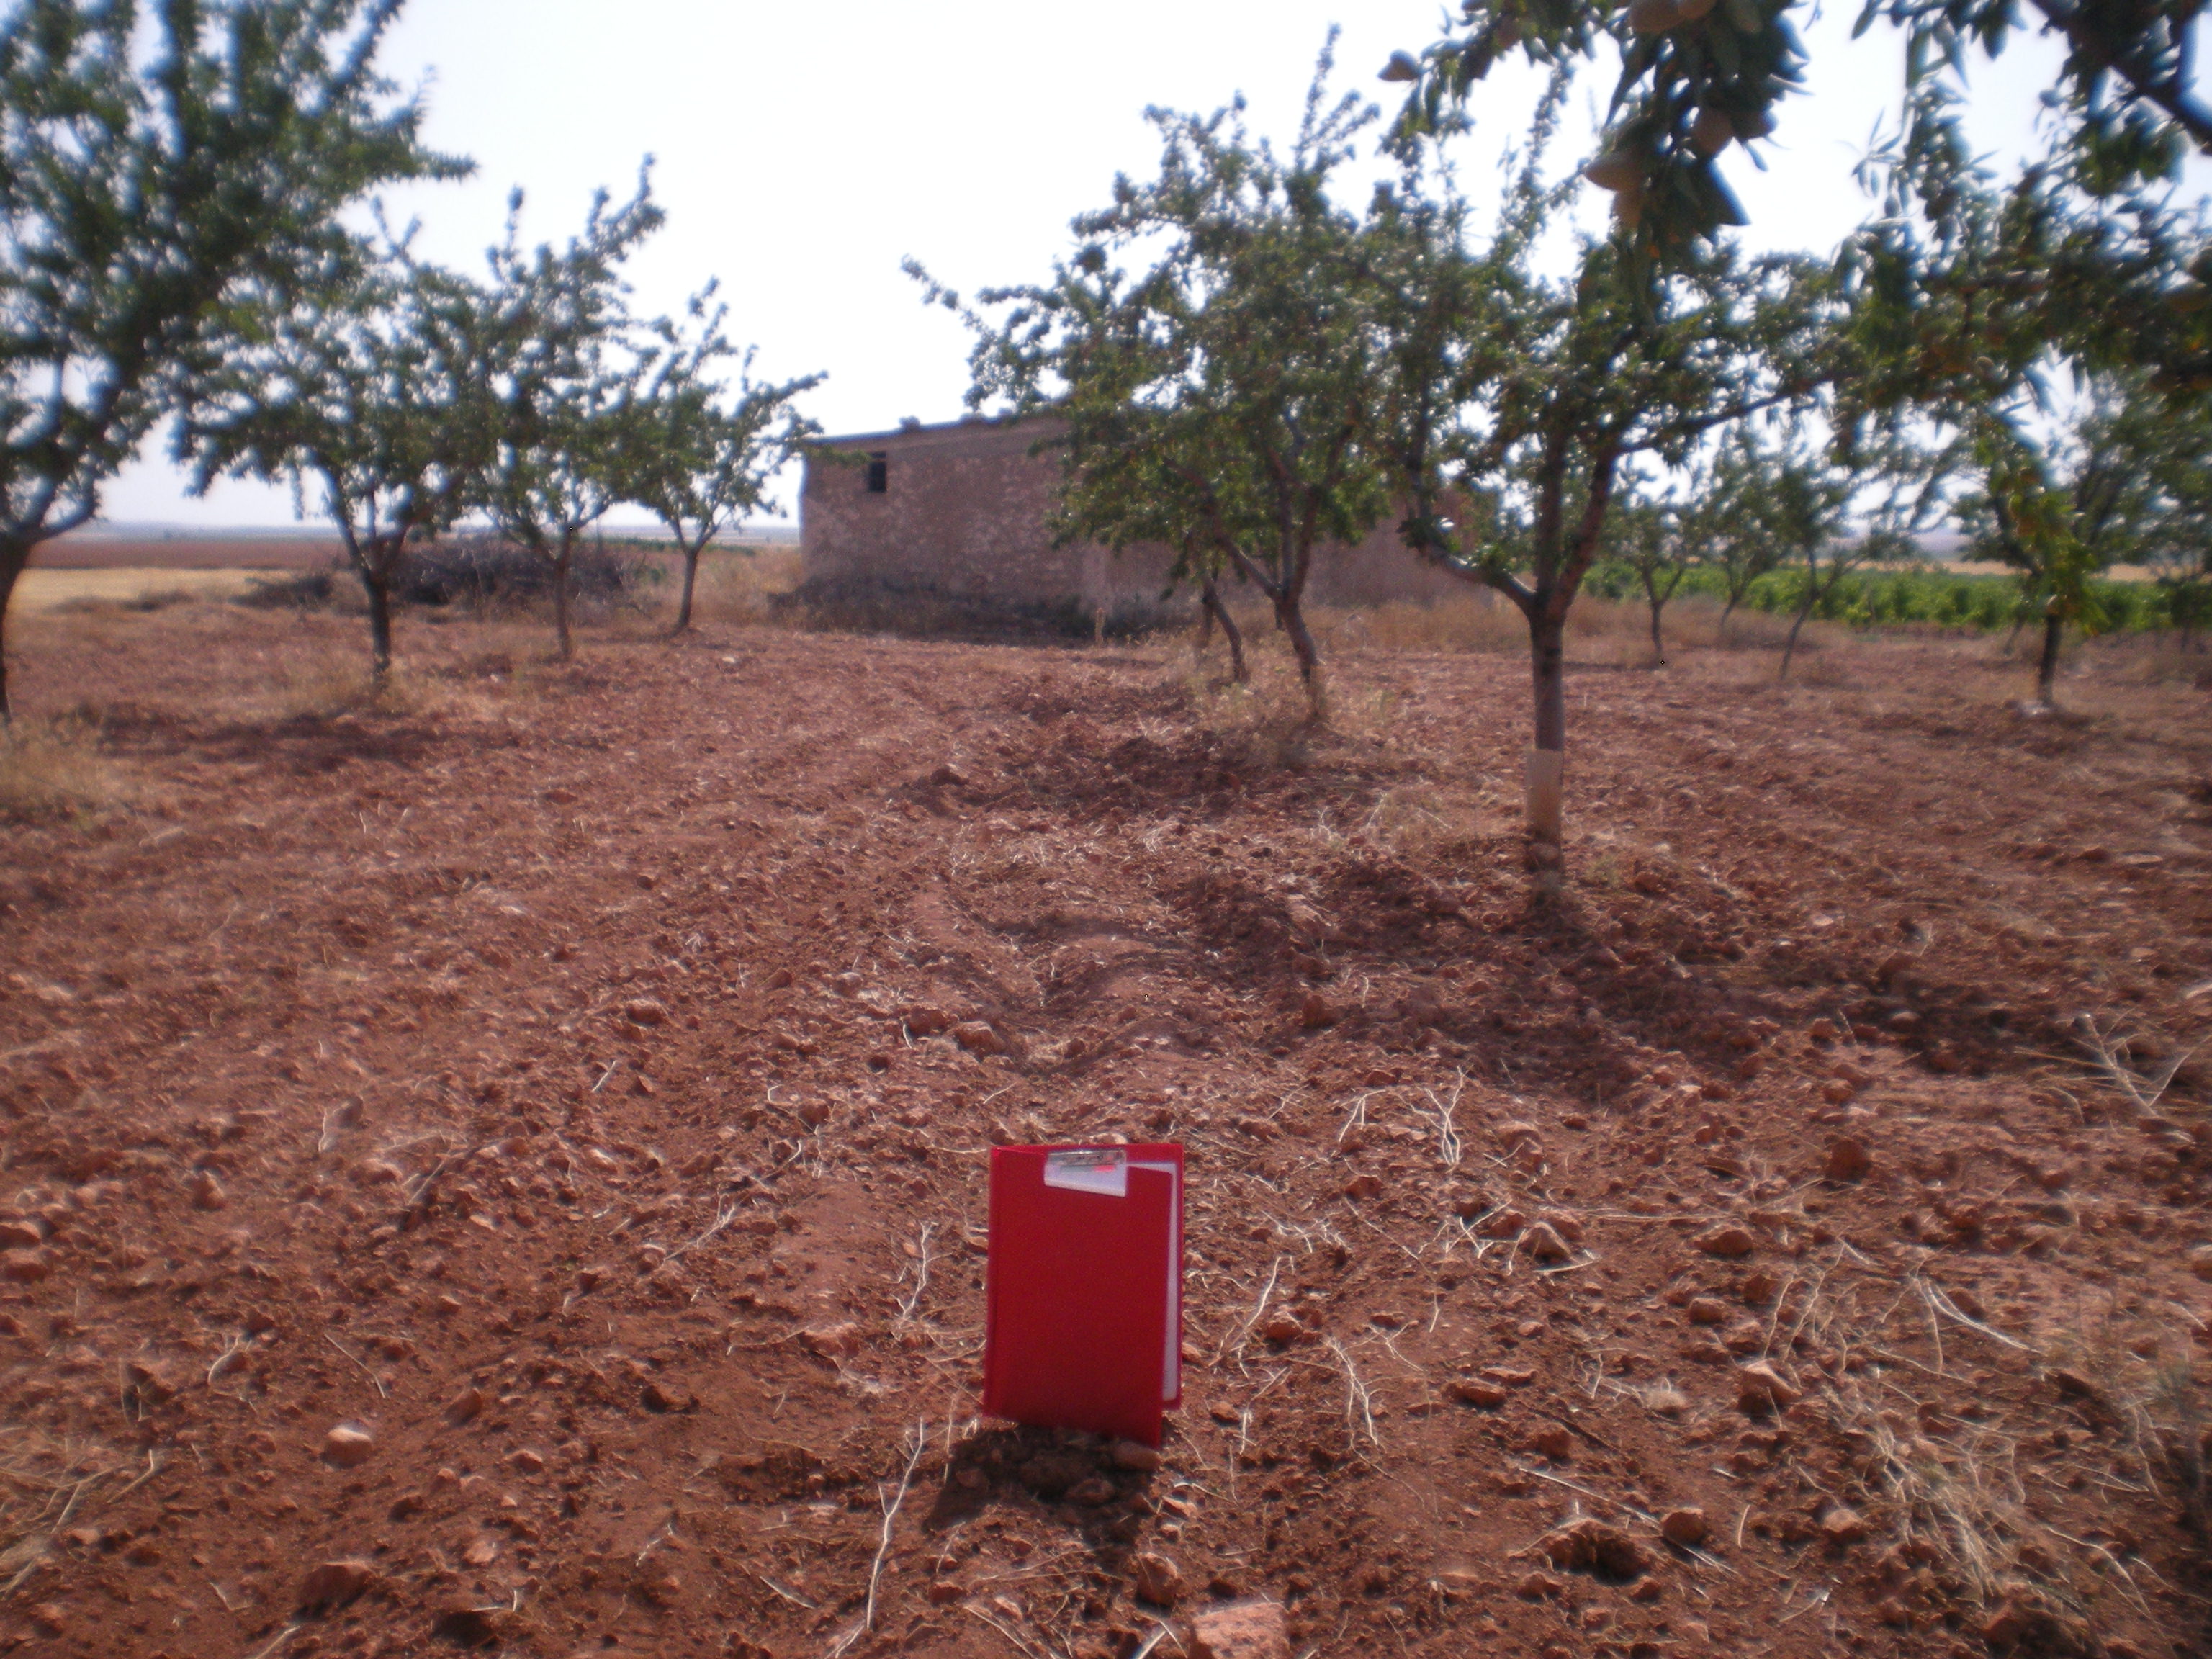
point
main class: Cropland
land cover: Nuts trees
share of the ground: 25 - 50 %
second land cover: Other bare soil
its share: > 75 %
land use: Agriculture (excluding fallow land and kitchen gardens)
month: June
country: ES
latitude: 39.5346
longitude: -3.3431
